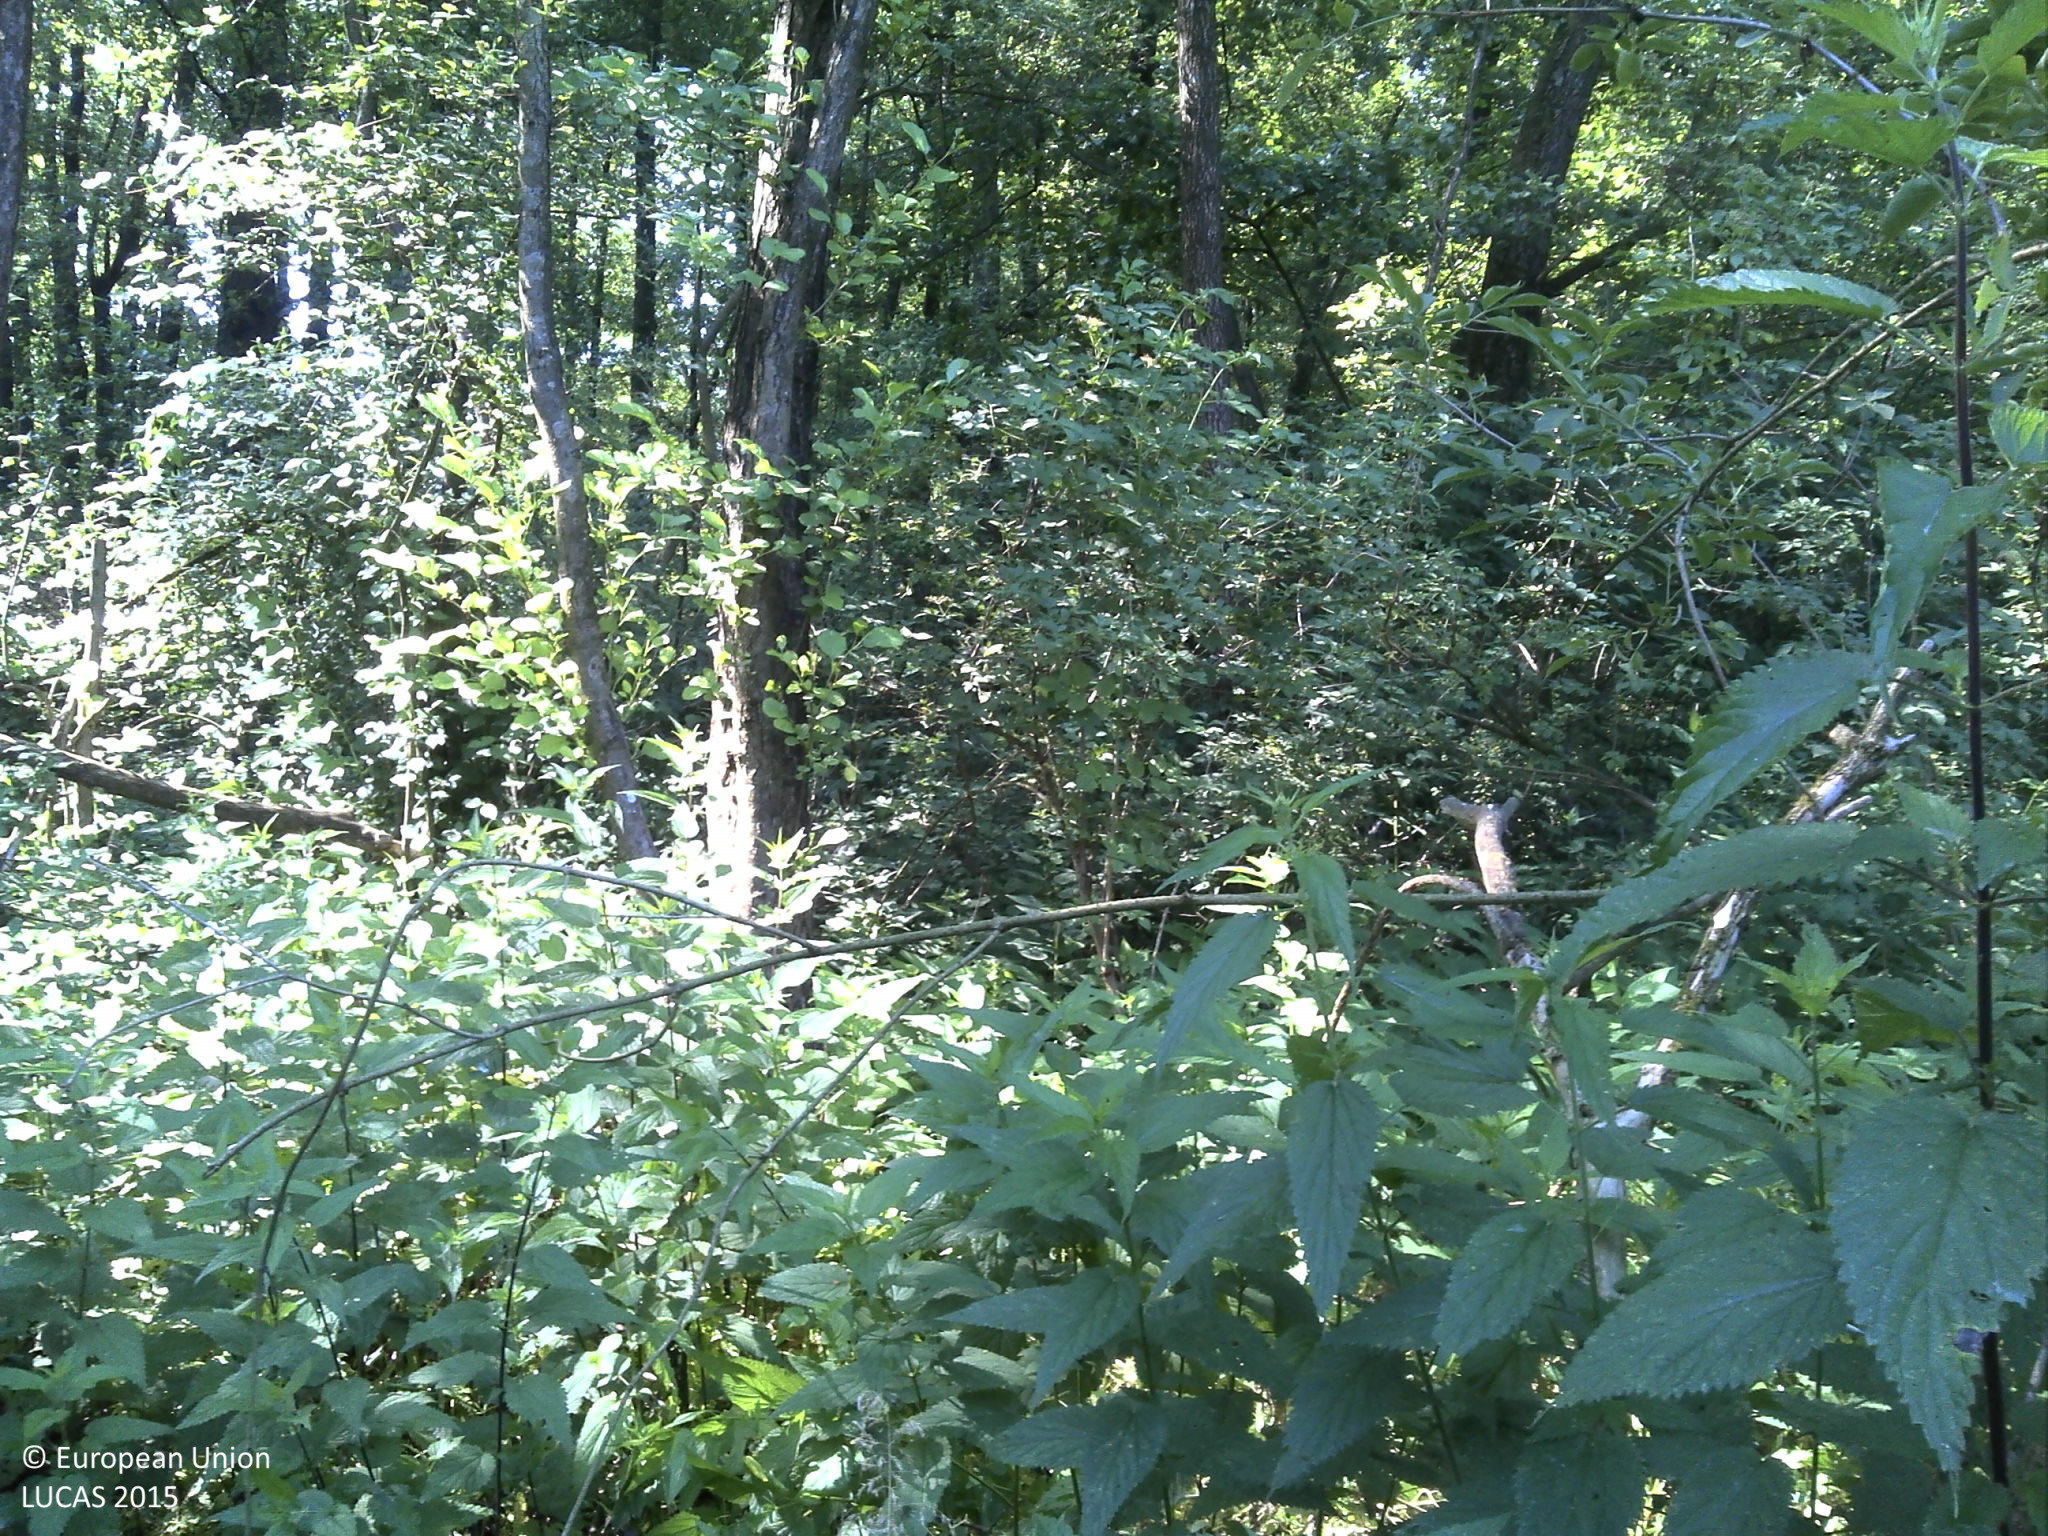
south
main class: Woodland
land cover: Broadleaved woodland
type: mesophytic deciduous forest
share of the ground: > 75 %
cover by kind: broadleaved forest trees 95 %, shrubs 5 %
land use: Forestry
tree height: > 5 m
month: June
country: HR
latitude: 45.3724
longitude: 17.8810
